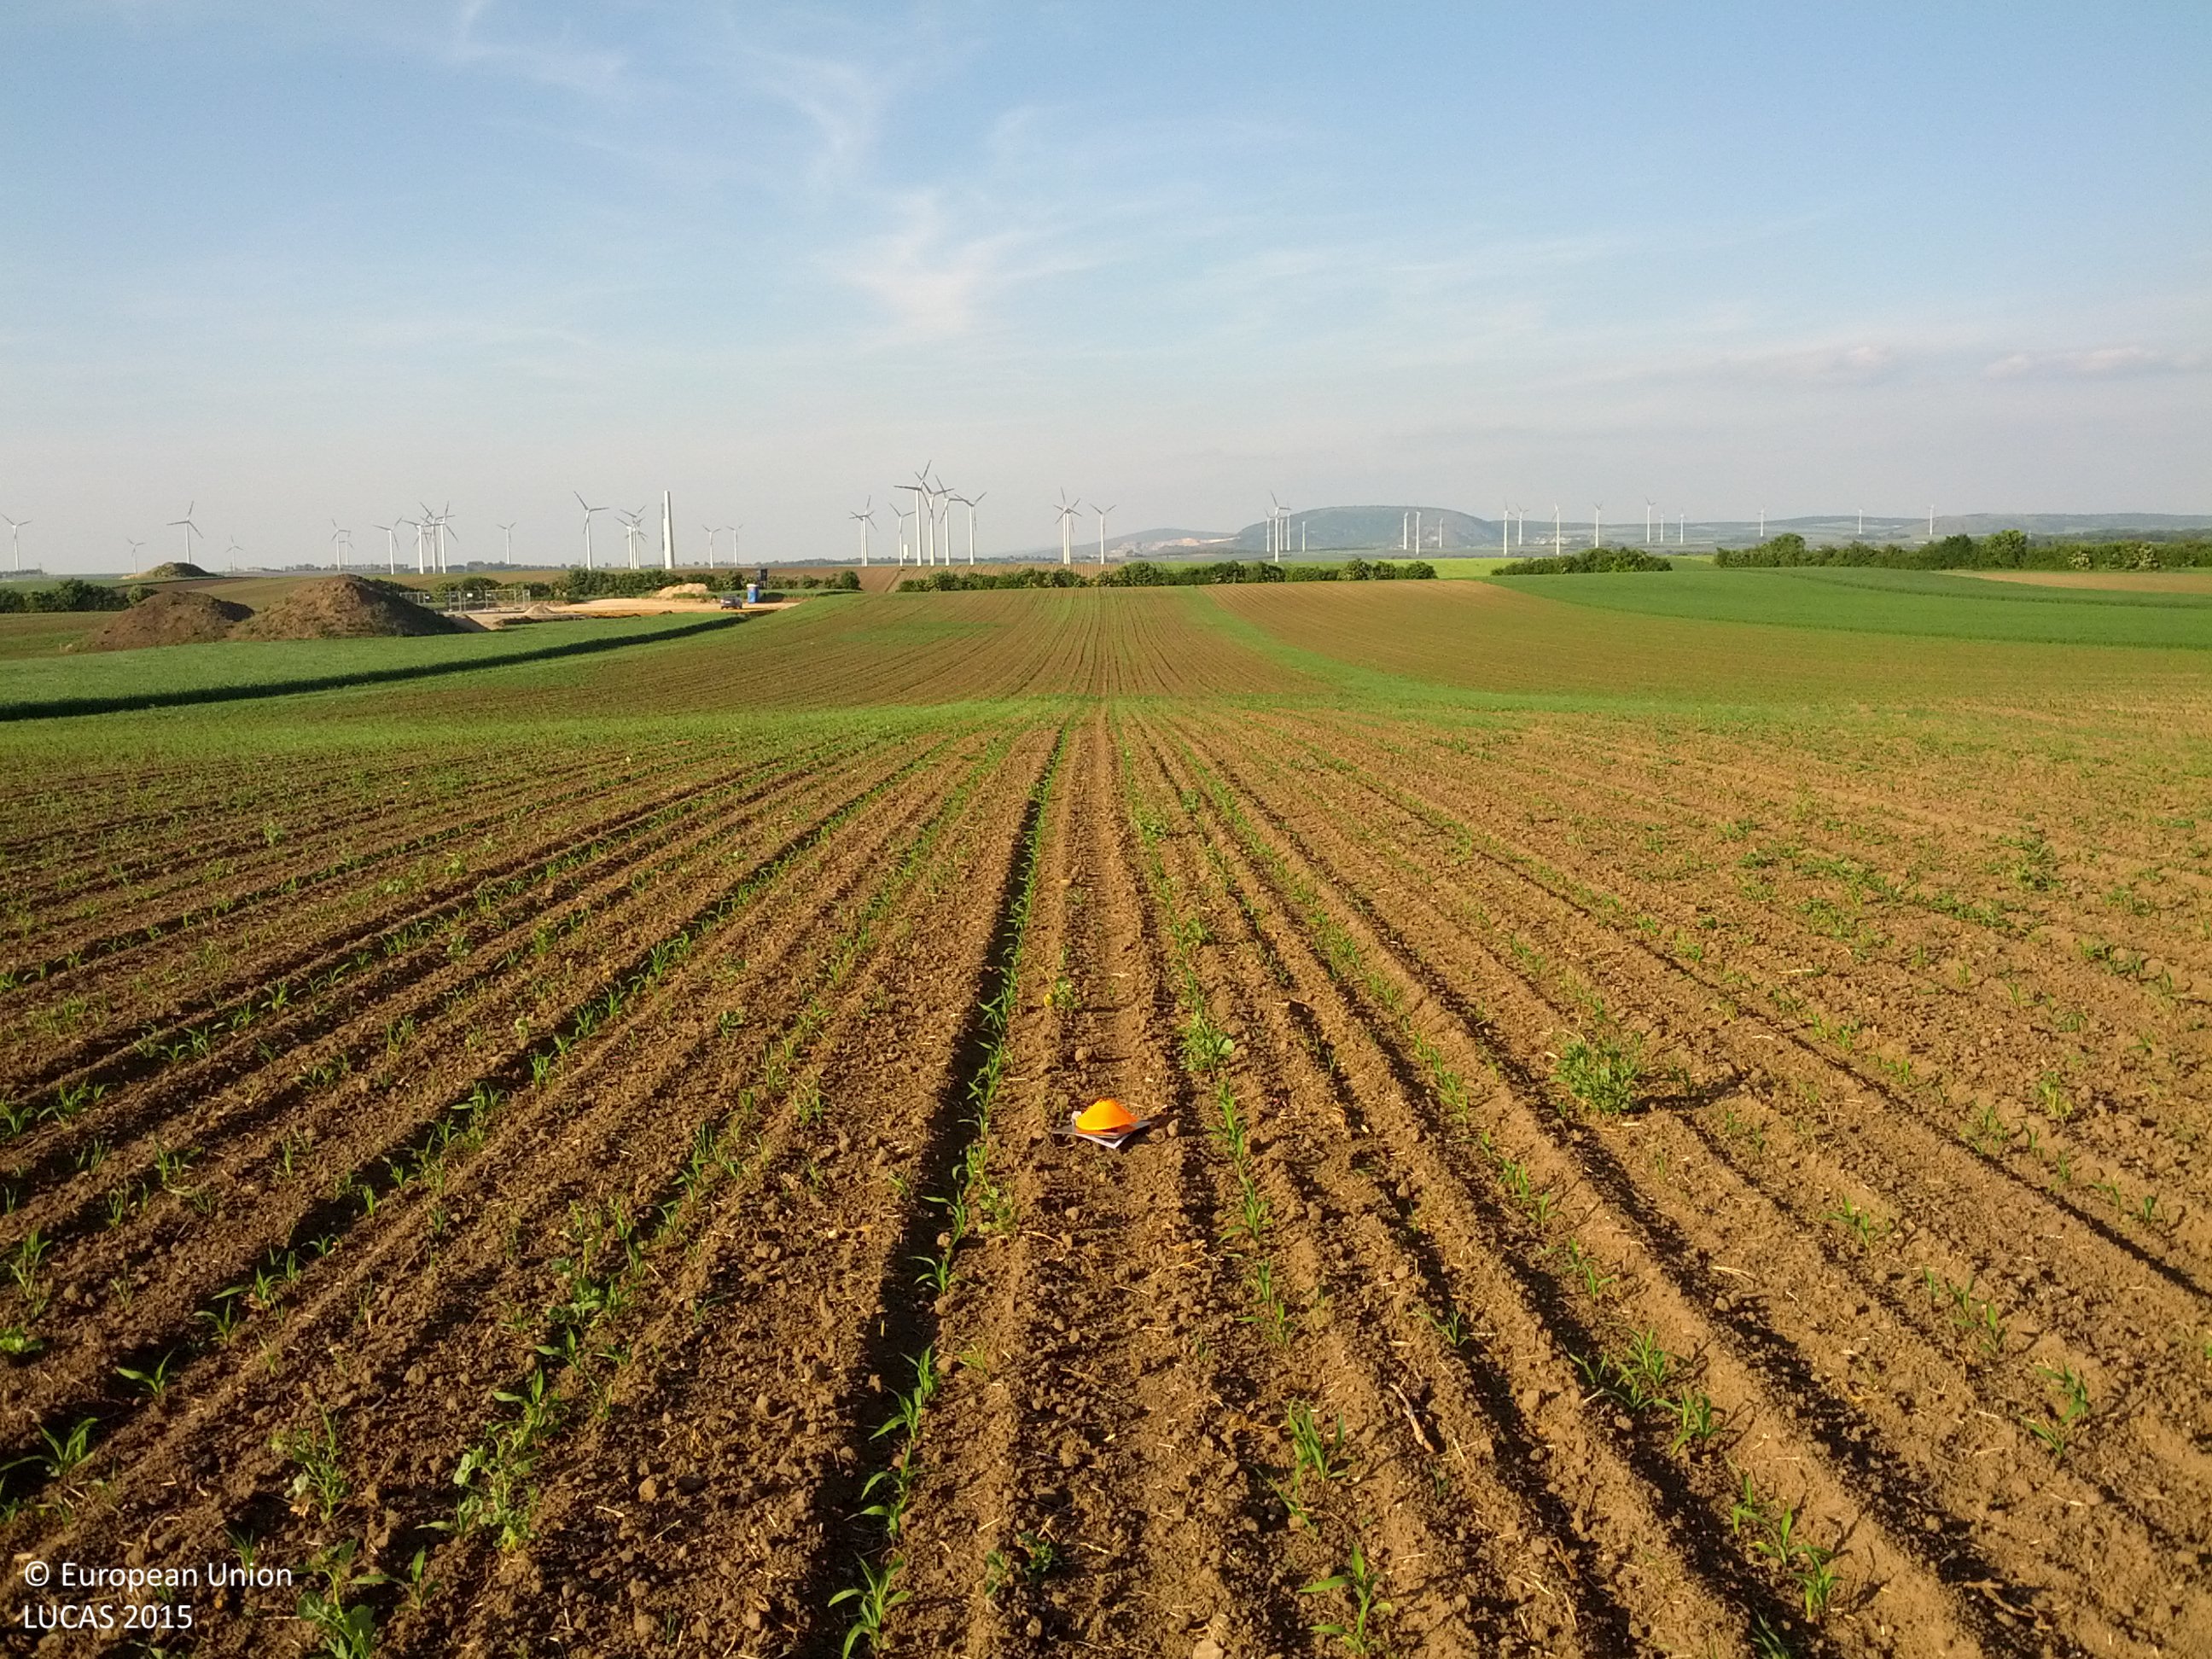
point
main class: Cropland
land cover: Maize
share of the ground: < 10 %
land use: Agriculture (excluding fallow land and kitchen gardens)
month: May
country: AT
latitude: 48.0491
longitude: 16.8079
